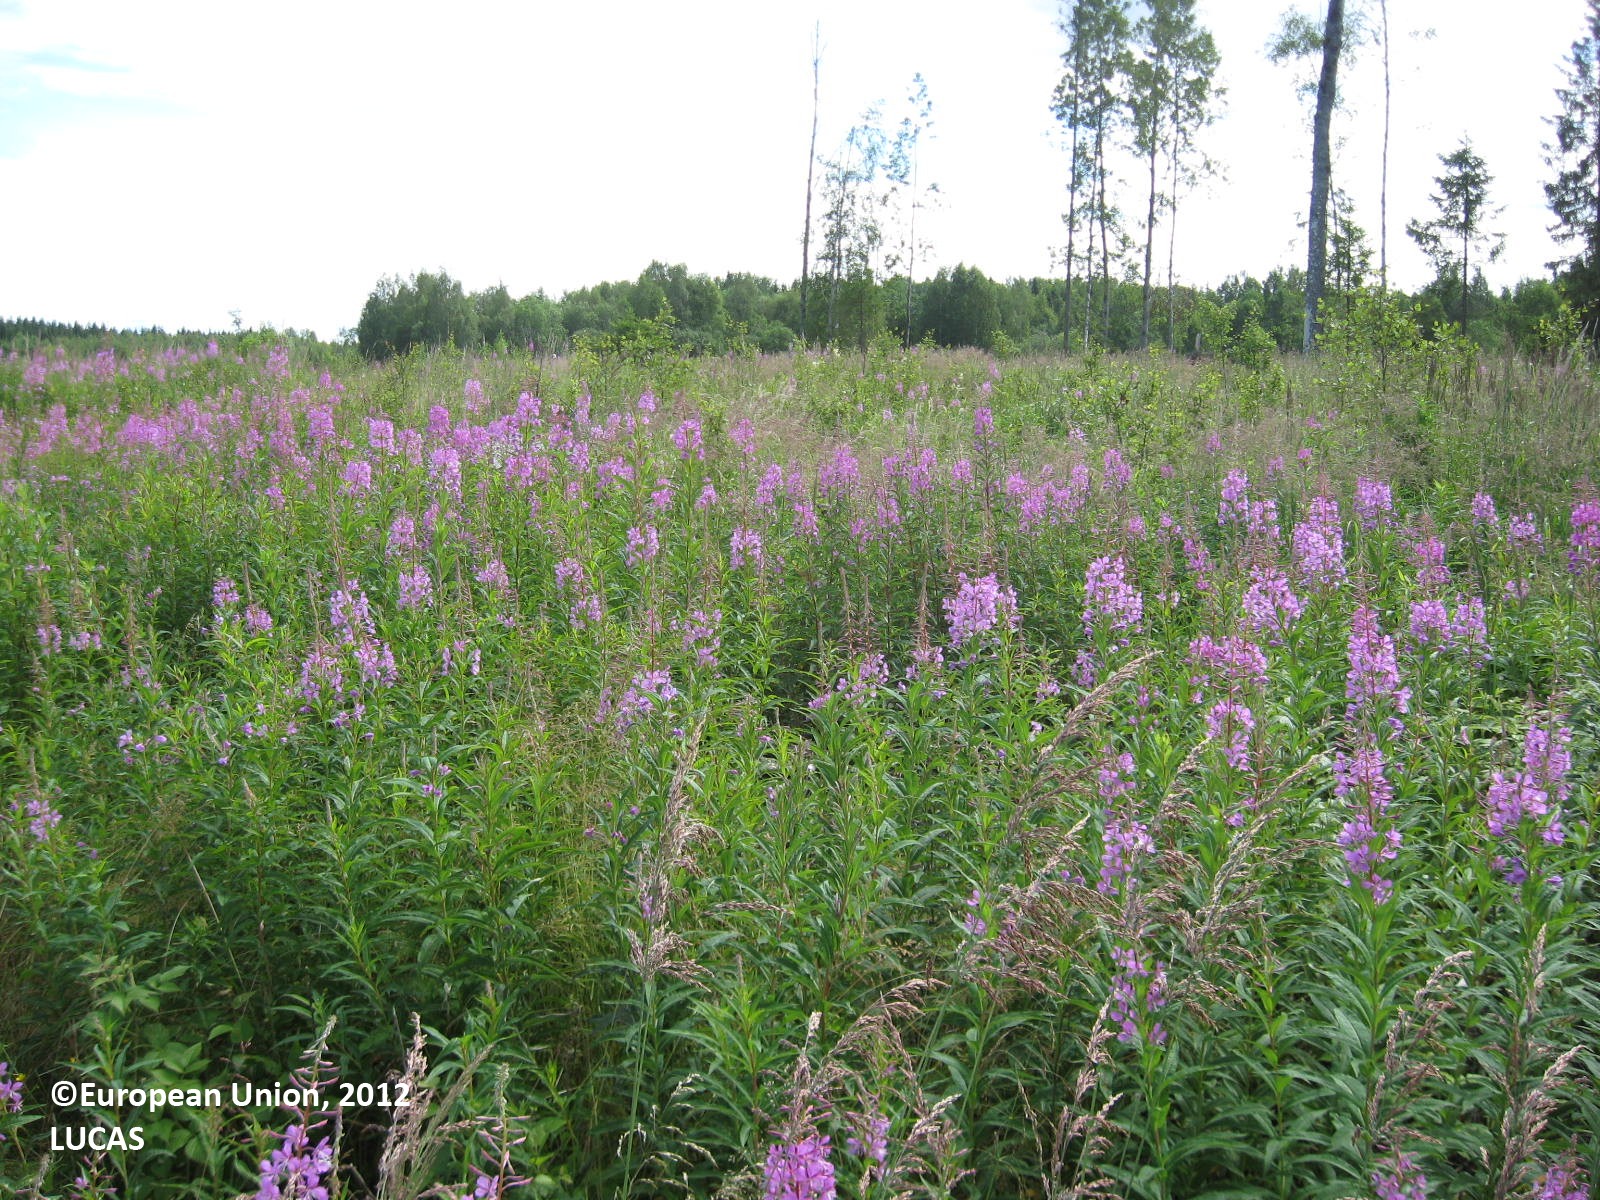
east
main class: Woodland
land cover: Broadleaved woodland
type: boreal forest
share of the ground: 10 - 25 %
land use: Forestry
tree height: < 5 m
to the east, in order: Broadleaved woodland; Grassland with sparse tree/shrub cover; Ditches and canals; Grass margins; Other root crops; Shruby margins; Ditches and canals; Shruby margins; Broadleaved woodland
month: July
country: FI
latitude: 62.2996
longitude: 21.4796
